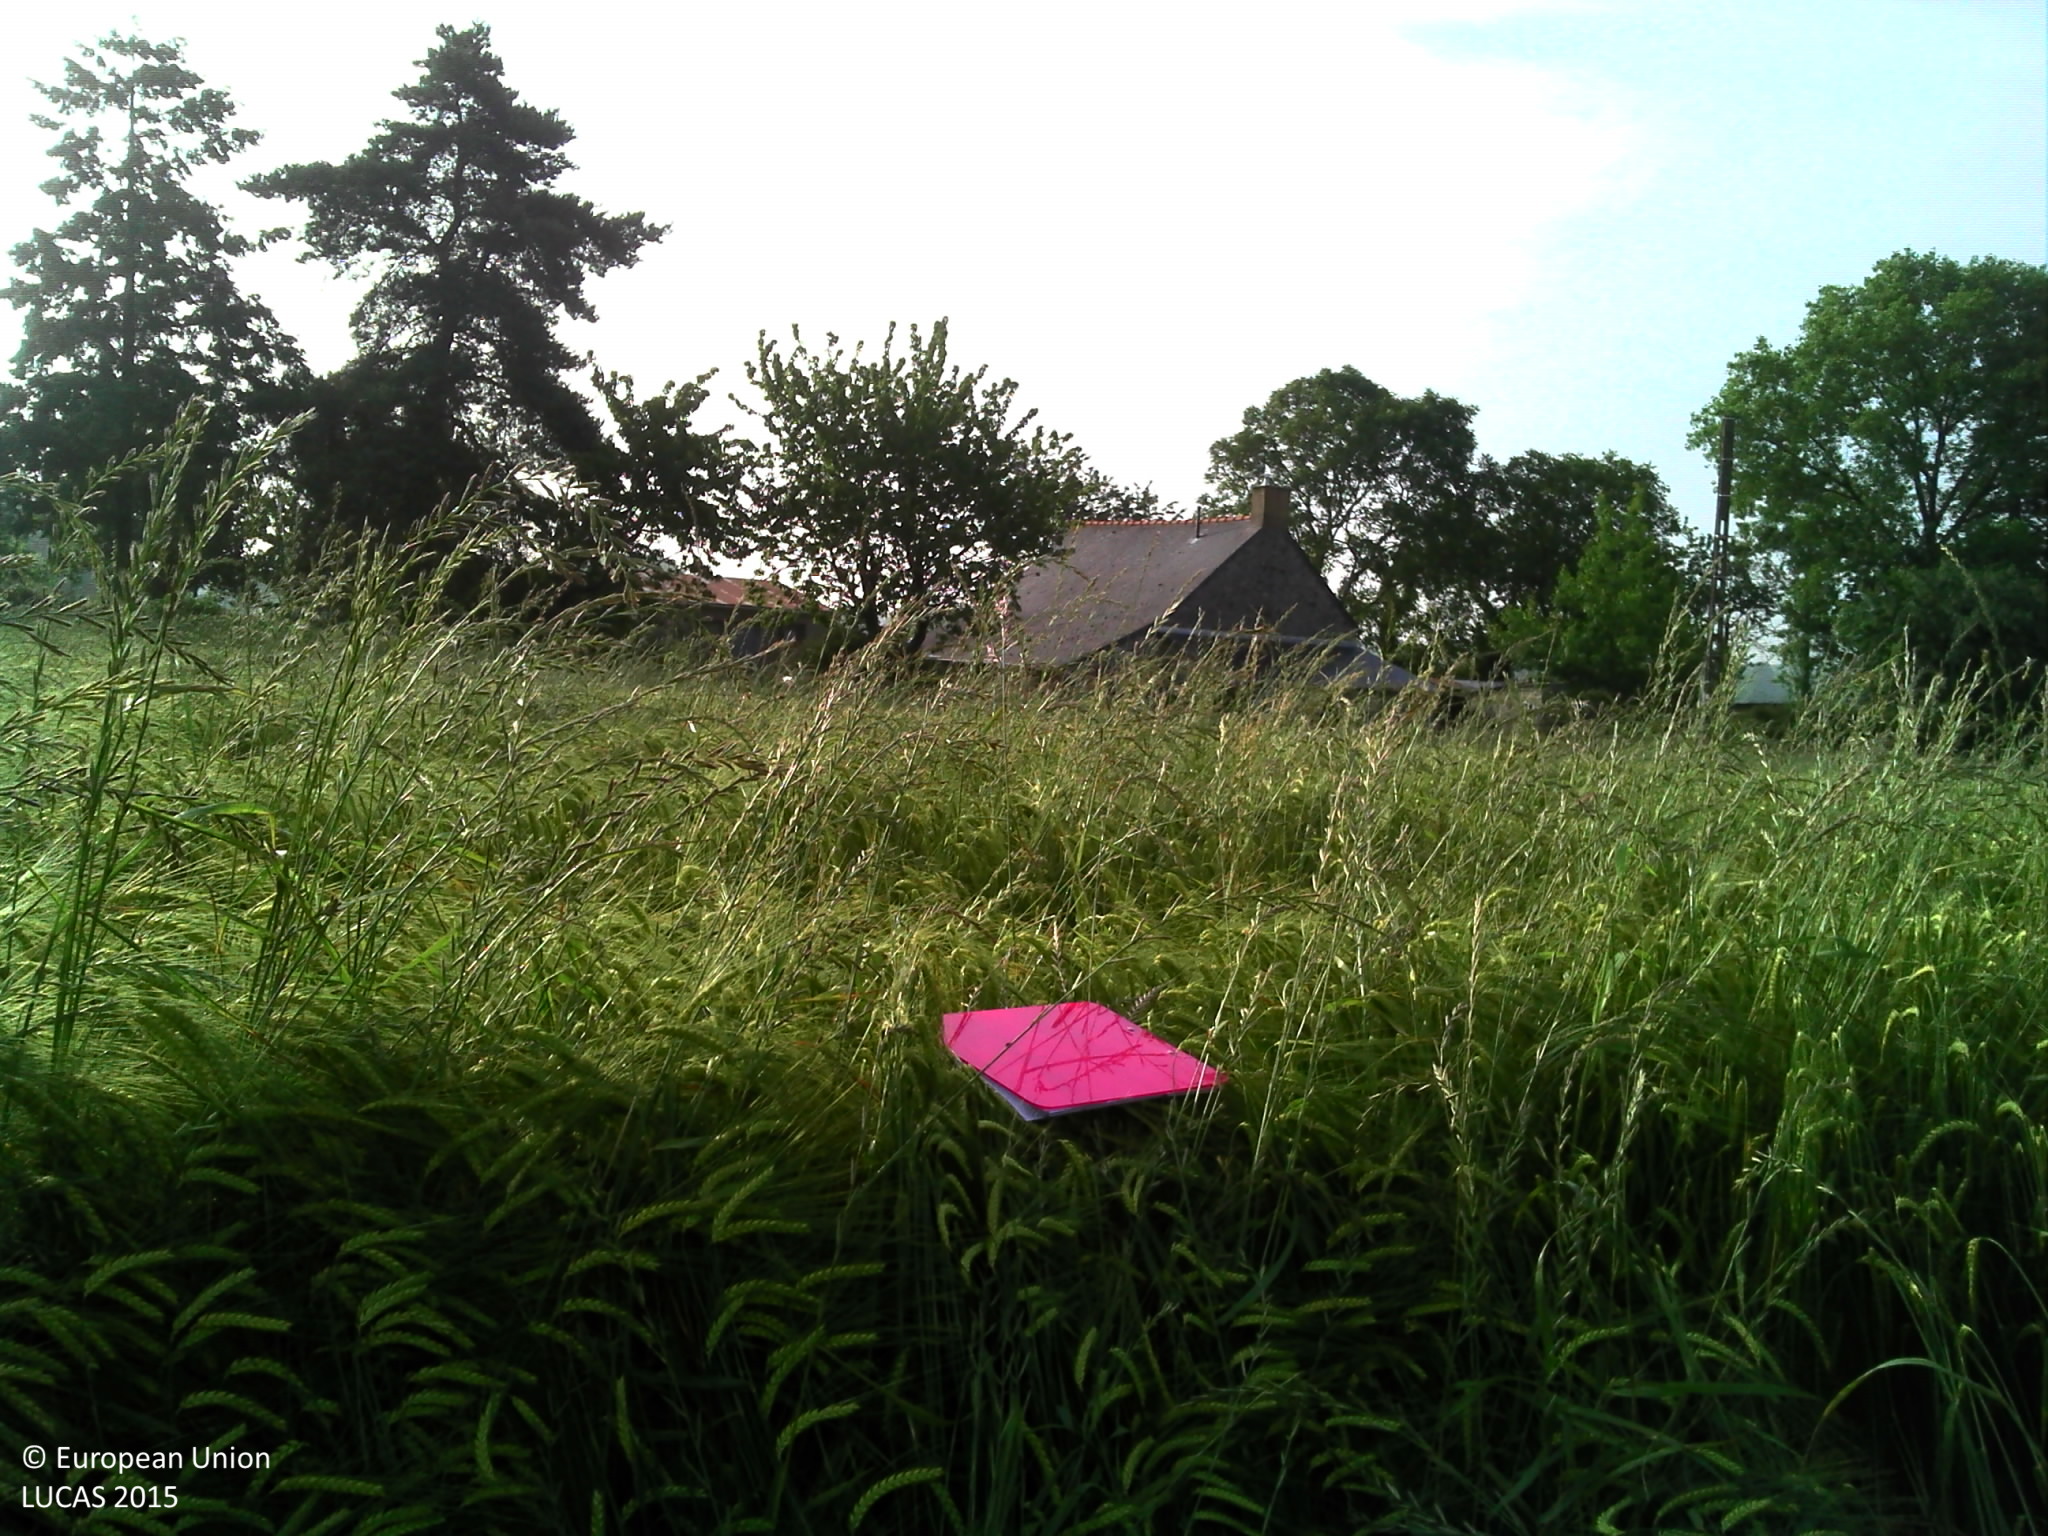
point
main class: Cropland
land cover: Barley
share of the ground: > 75 %
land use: Agriculture (excluding fallow land and kitchen gardens)
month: June
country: FR
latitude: 48.4151
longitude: -1.7098
